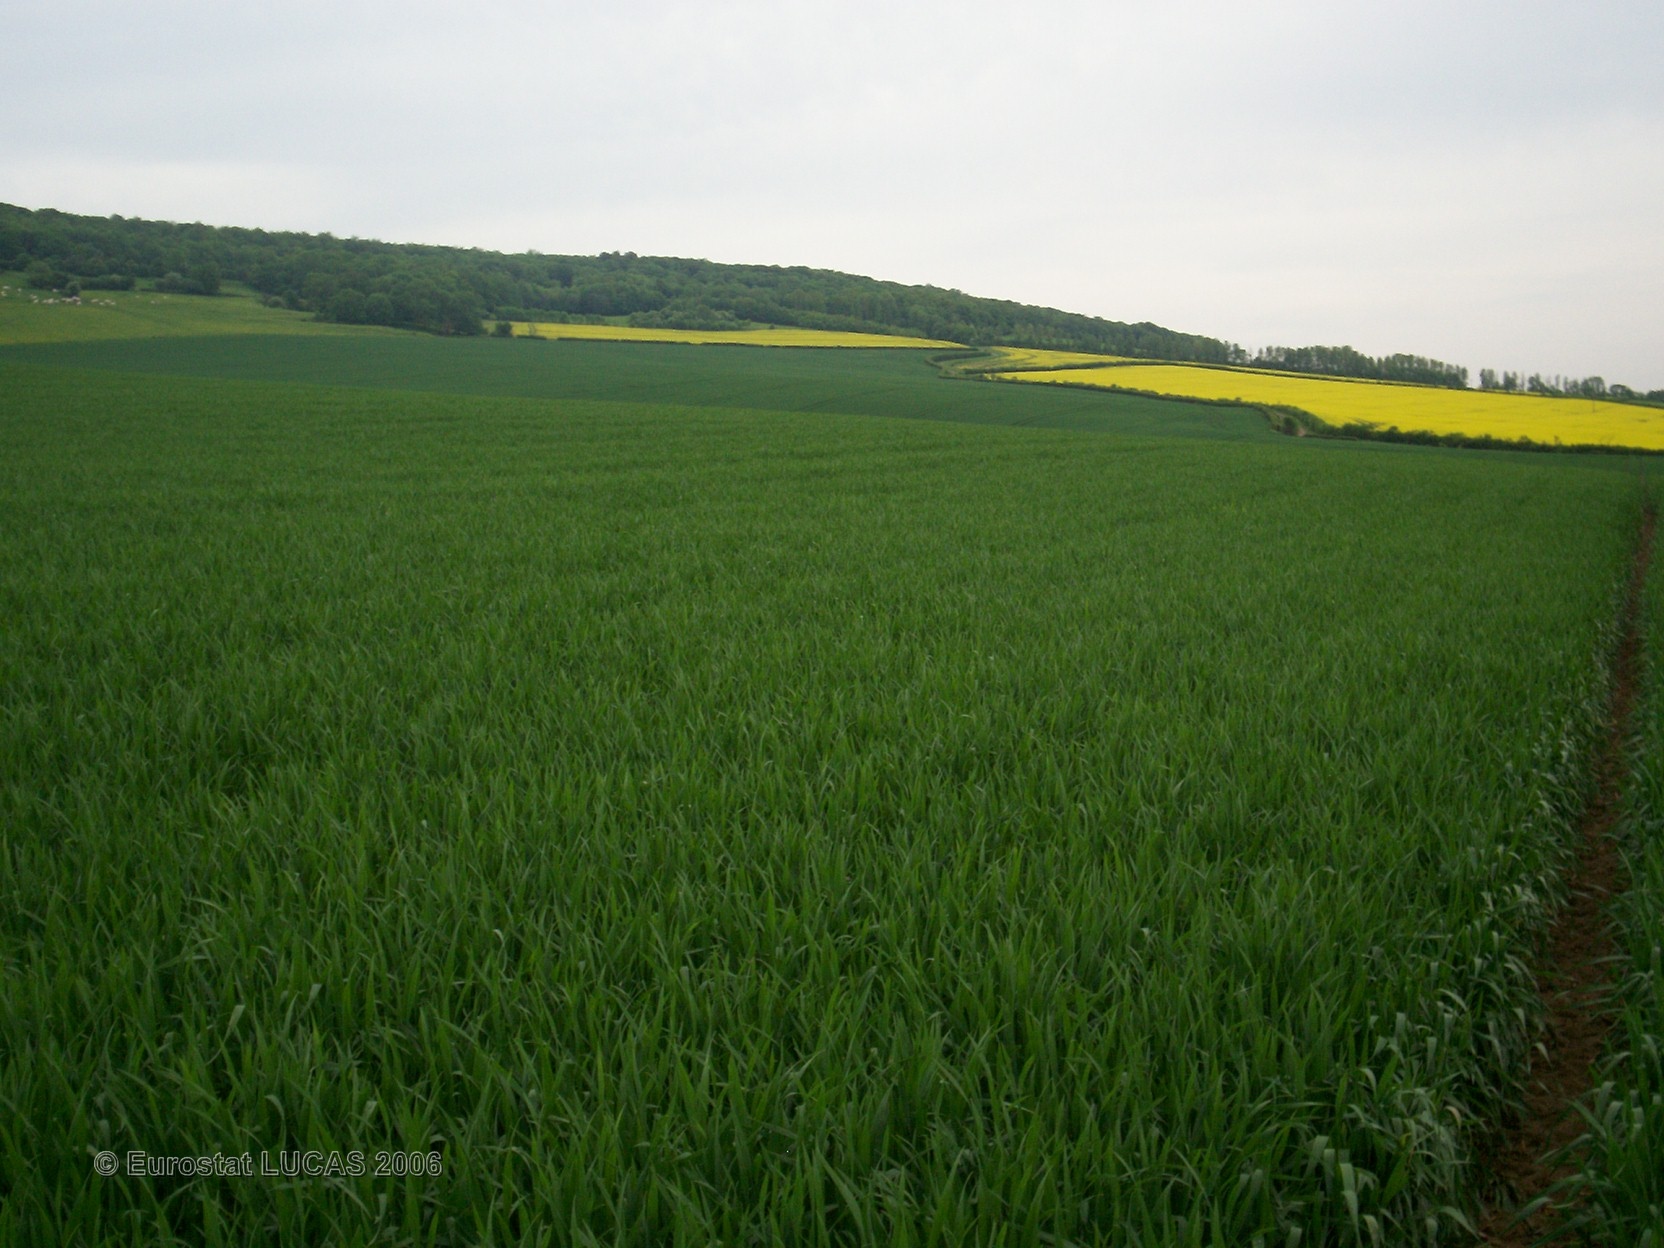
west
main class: Cropland
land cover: Common wheat
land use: Agriculture (excluding fallow land and kitchen gardens)
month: May
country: FR
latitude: 47.2459
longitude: 4.6492
